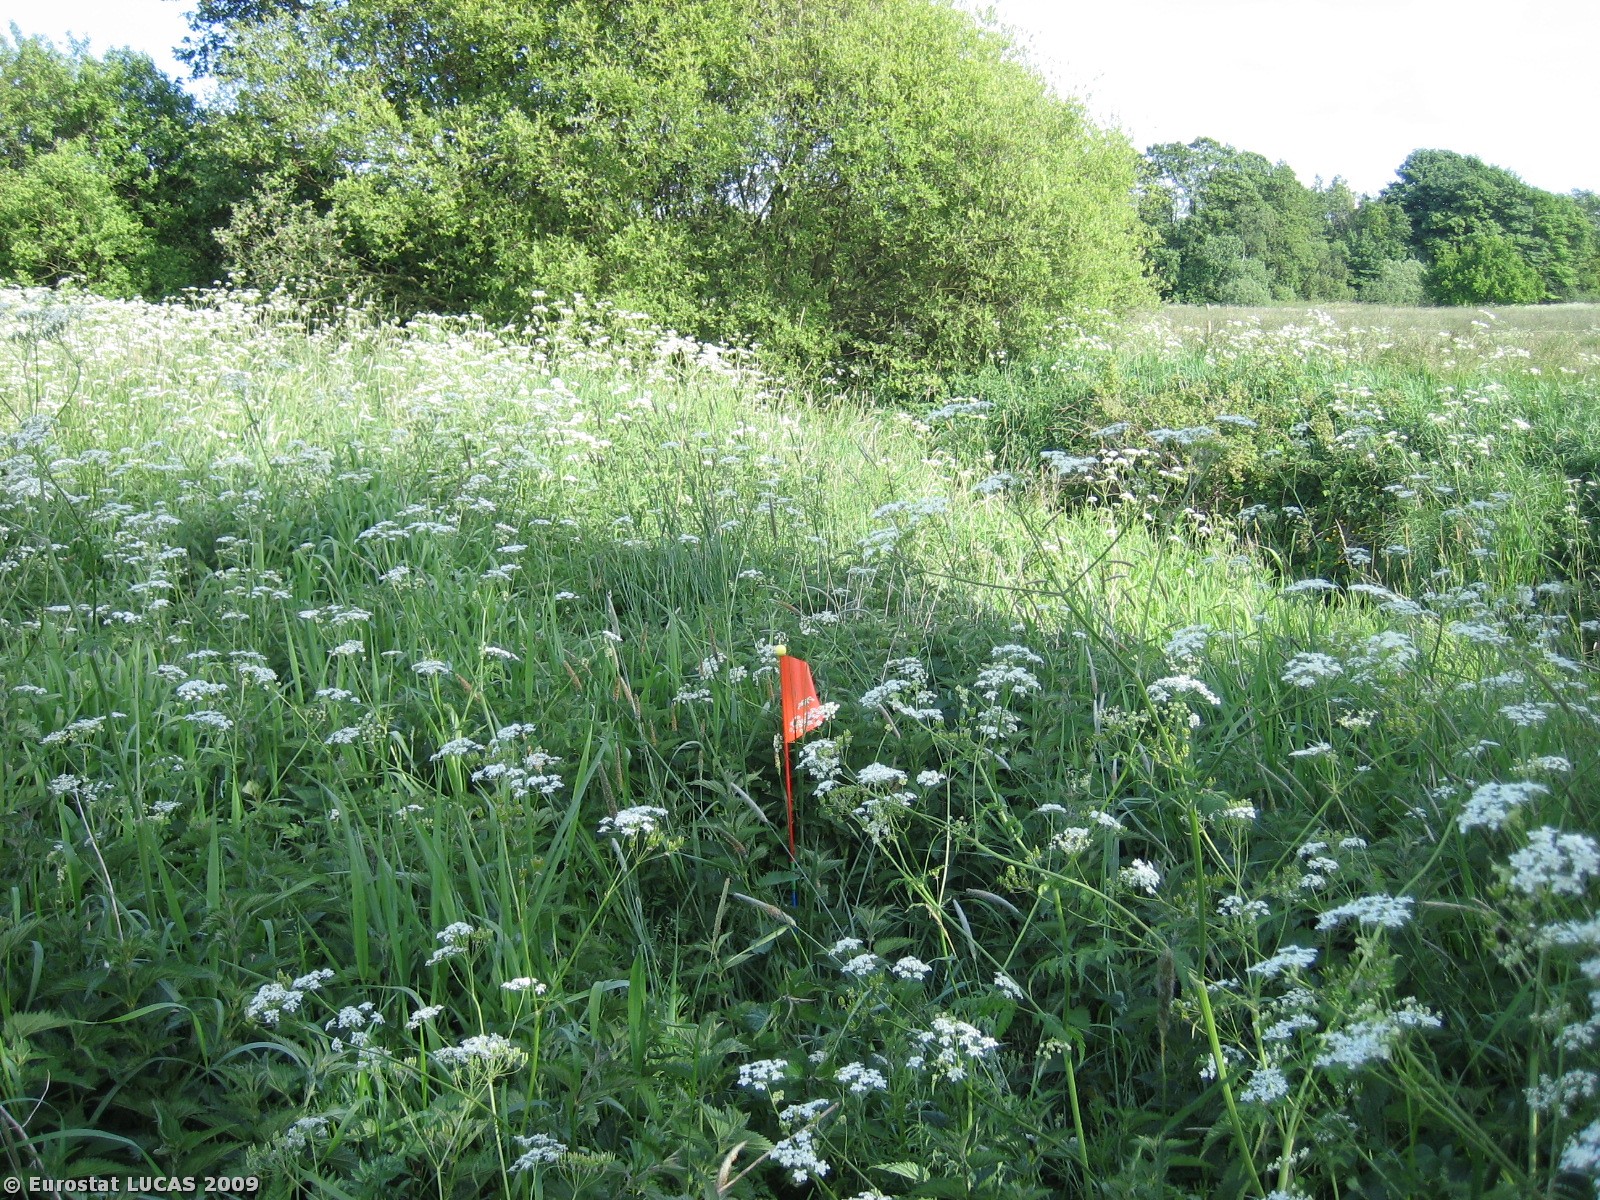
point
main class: Grassland
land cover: Grassland without tree/shrub cover
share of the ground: > 75 %
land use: Unused
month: June
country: DK
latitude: 56.1697
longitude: 9.8552
